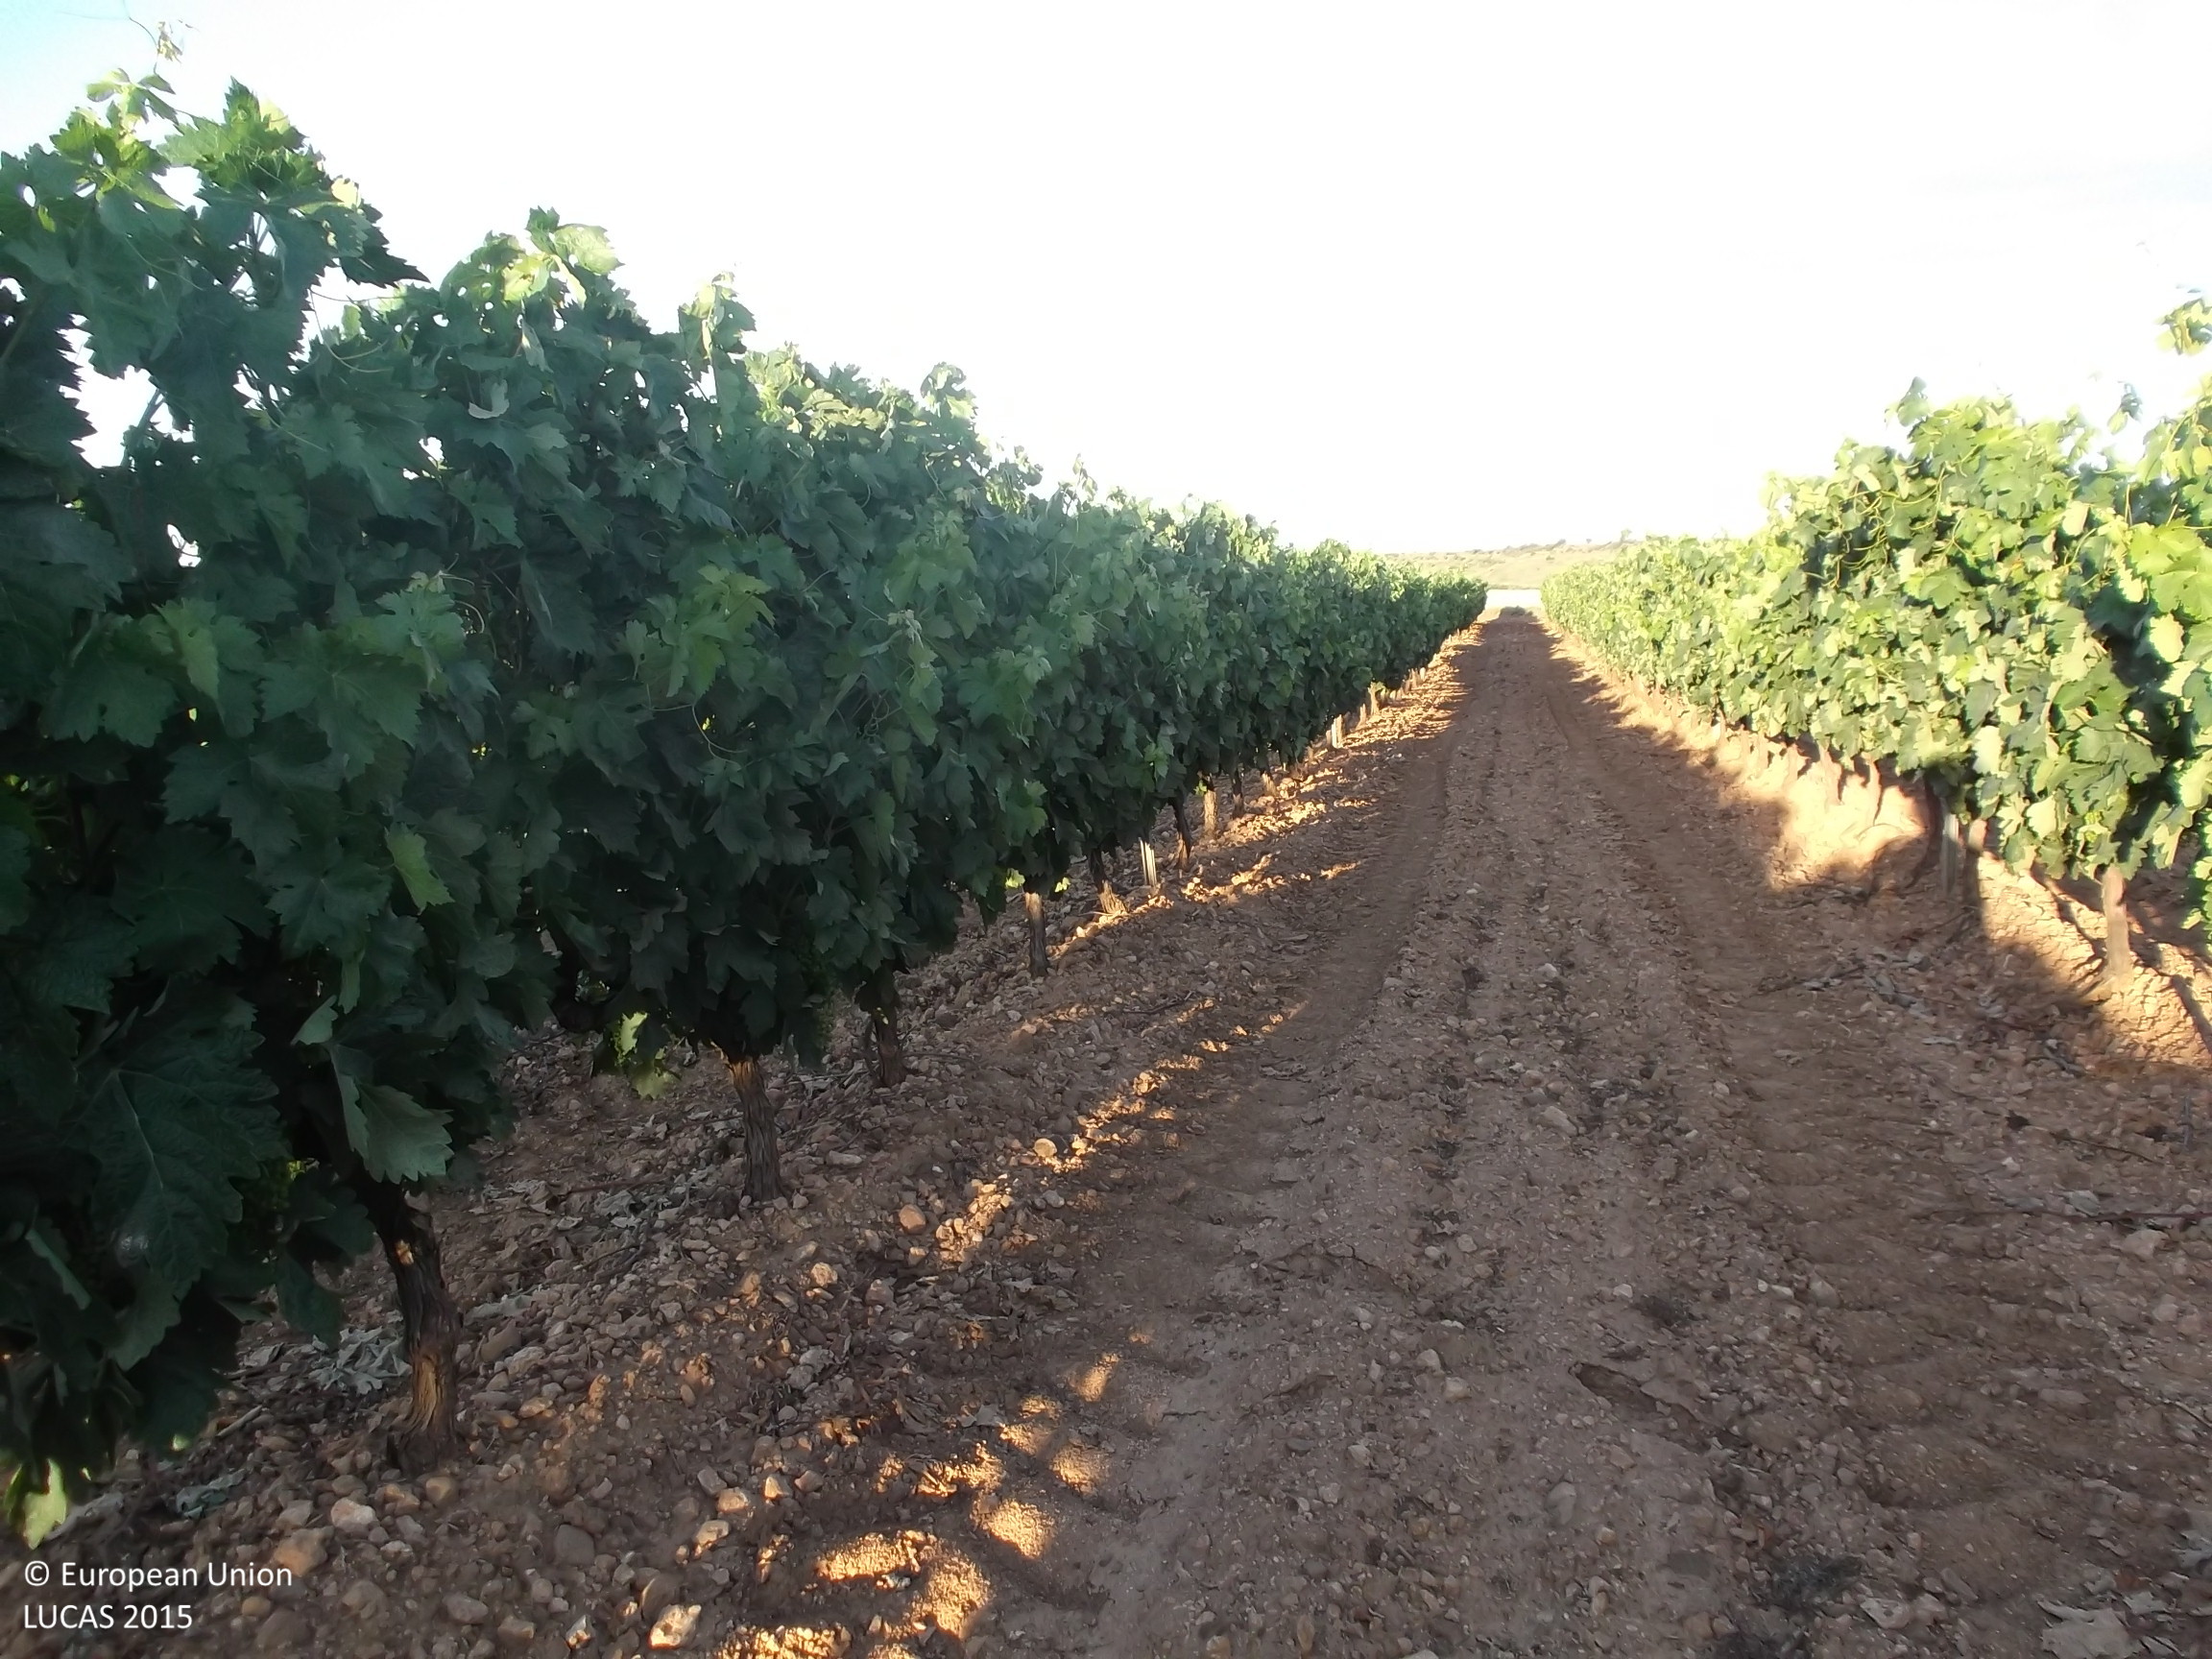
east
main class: Cropland
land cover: Vineyards
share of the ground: < 10 %
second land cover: Other bare soil
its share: > 75 %
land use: Agriculture (excluding fallow land and kitchen gardens)
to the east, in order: Vineyards; Other bare soil; Grass margins; Barley
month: June
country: ES
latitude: 42.3432
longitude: -2.1174
